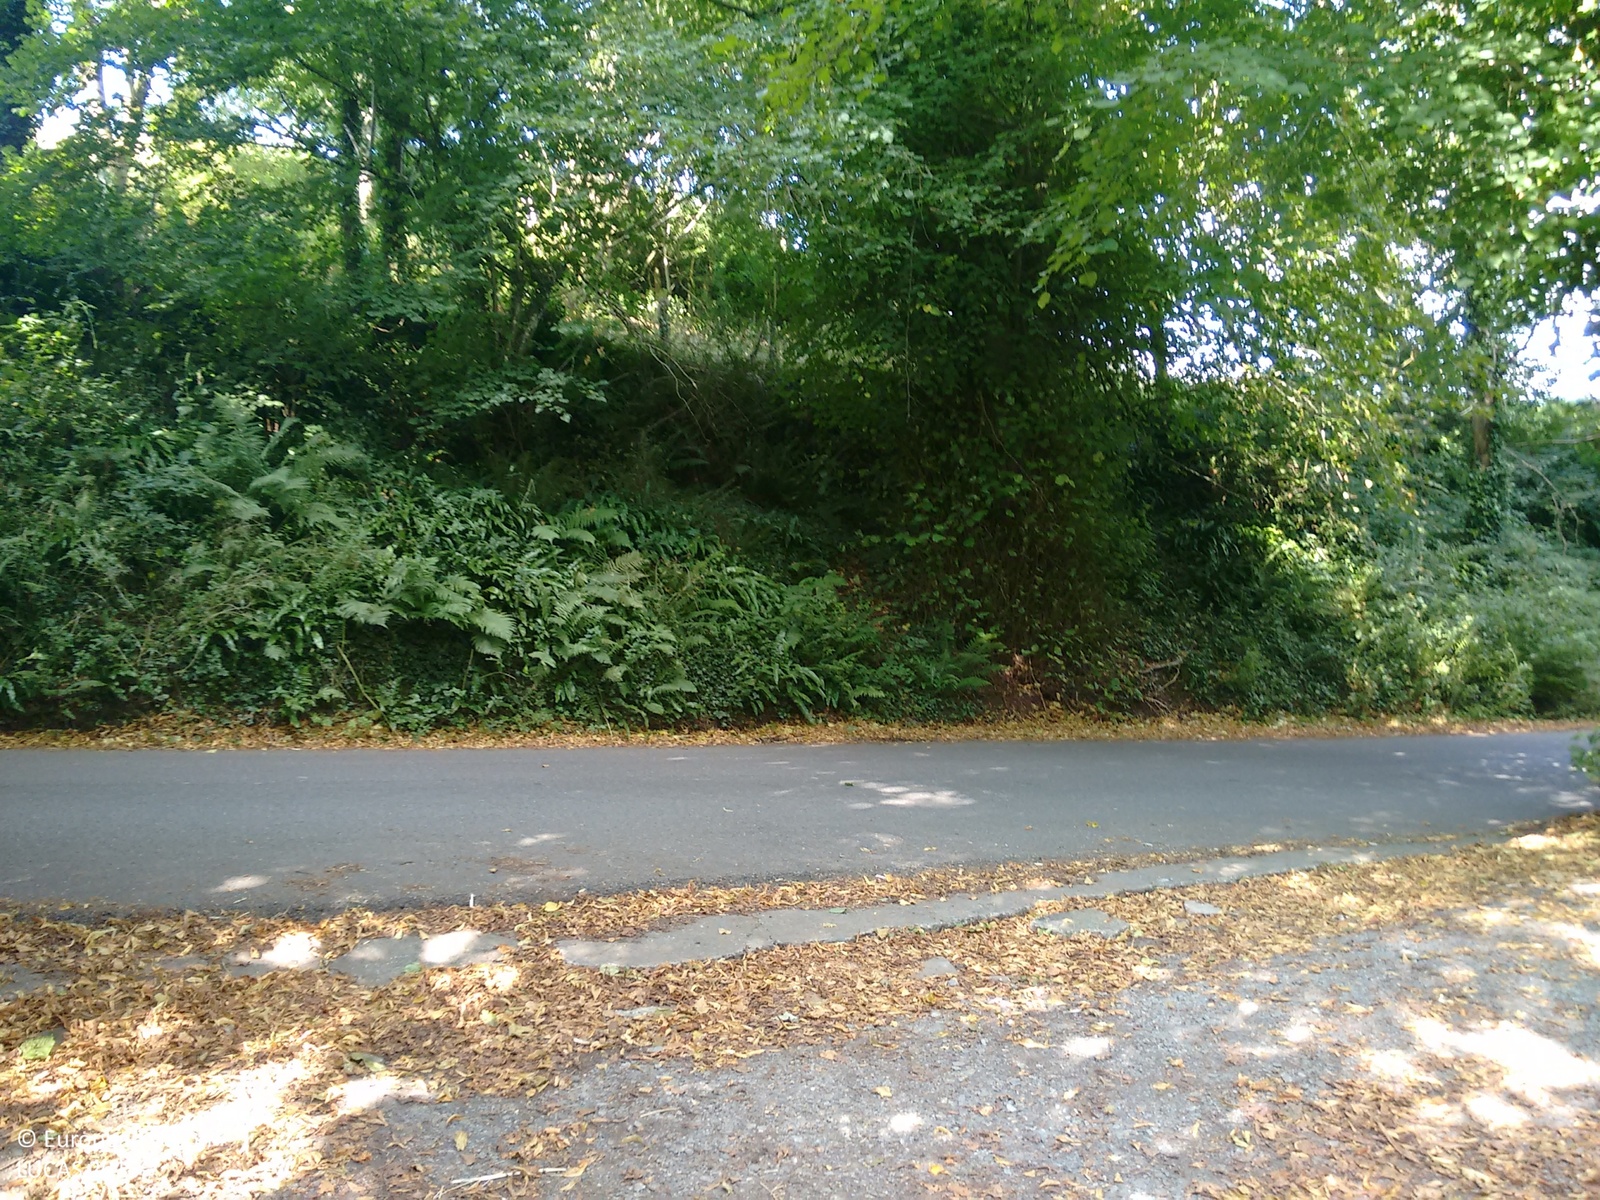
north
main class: Woodland
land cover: Broadleaved woodland
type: mesophytic deciduous forest
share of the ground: > 75 %
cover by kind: broadleaved forest trees 100 %
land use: Semi-natural and natural areas not in use
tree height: > 5 m
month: September
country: GB
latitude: 50.9580
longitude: -4.1491
